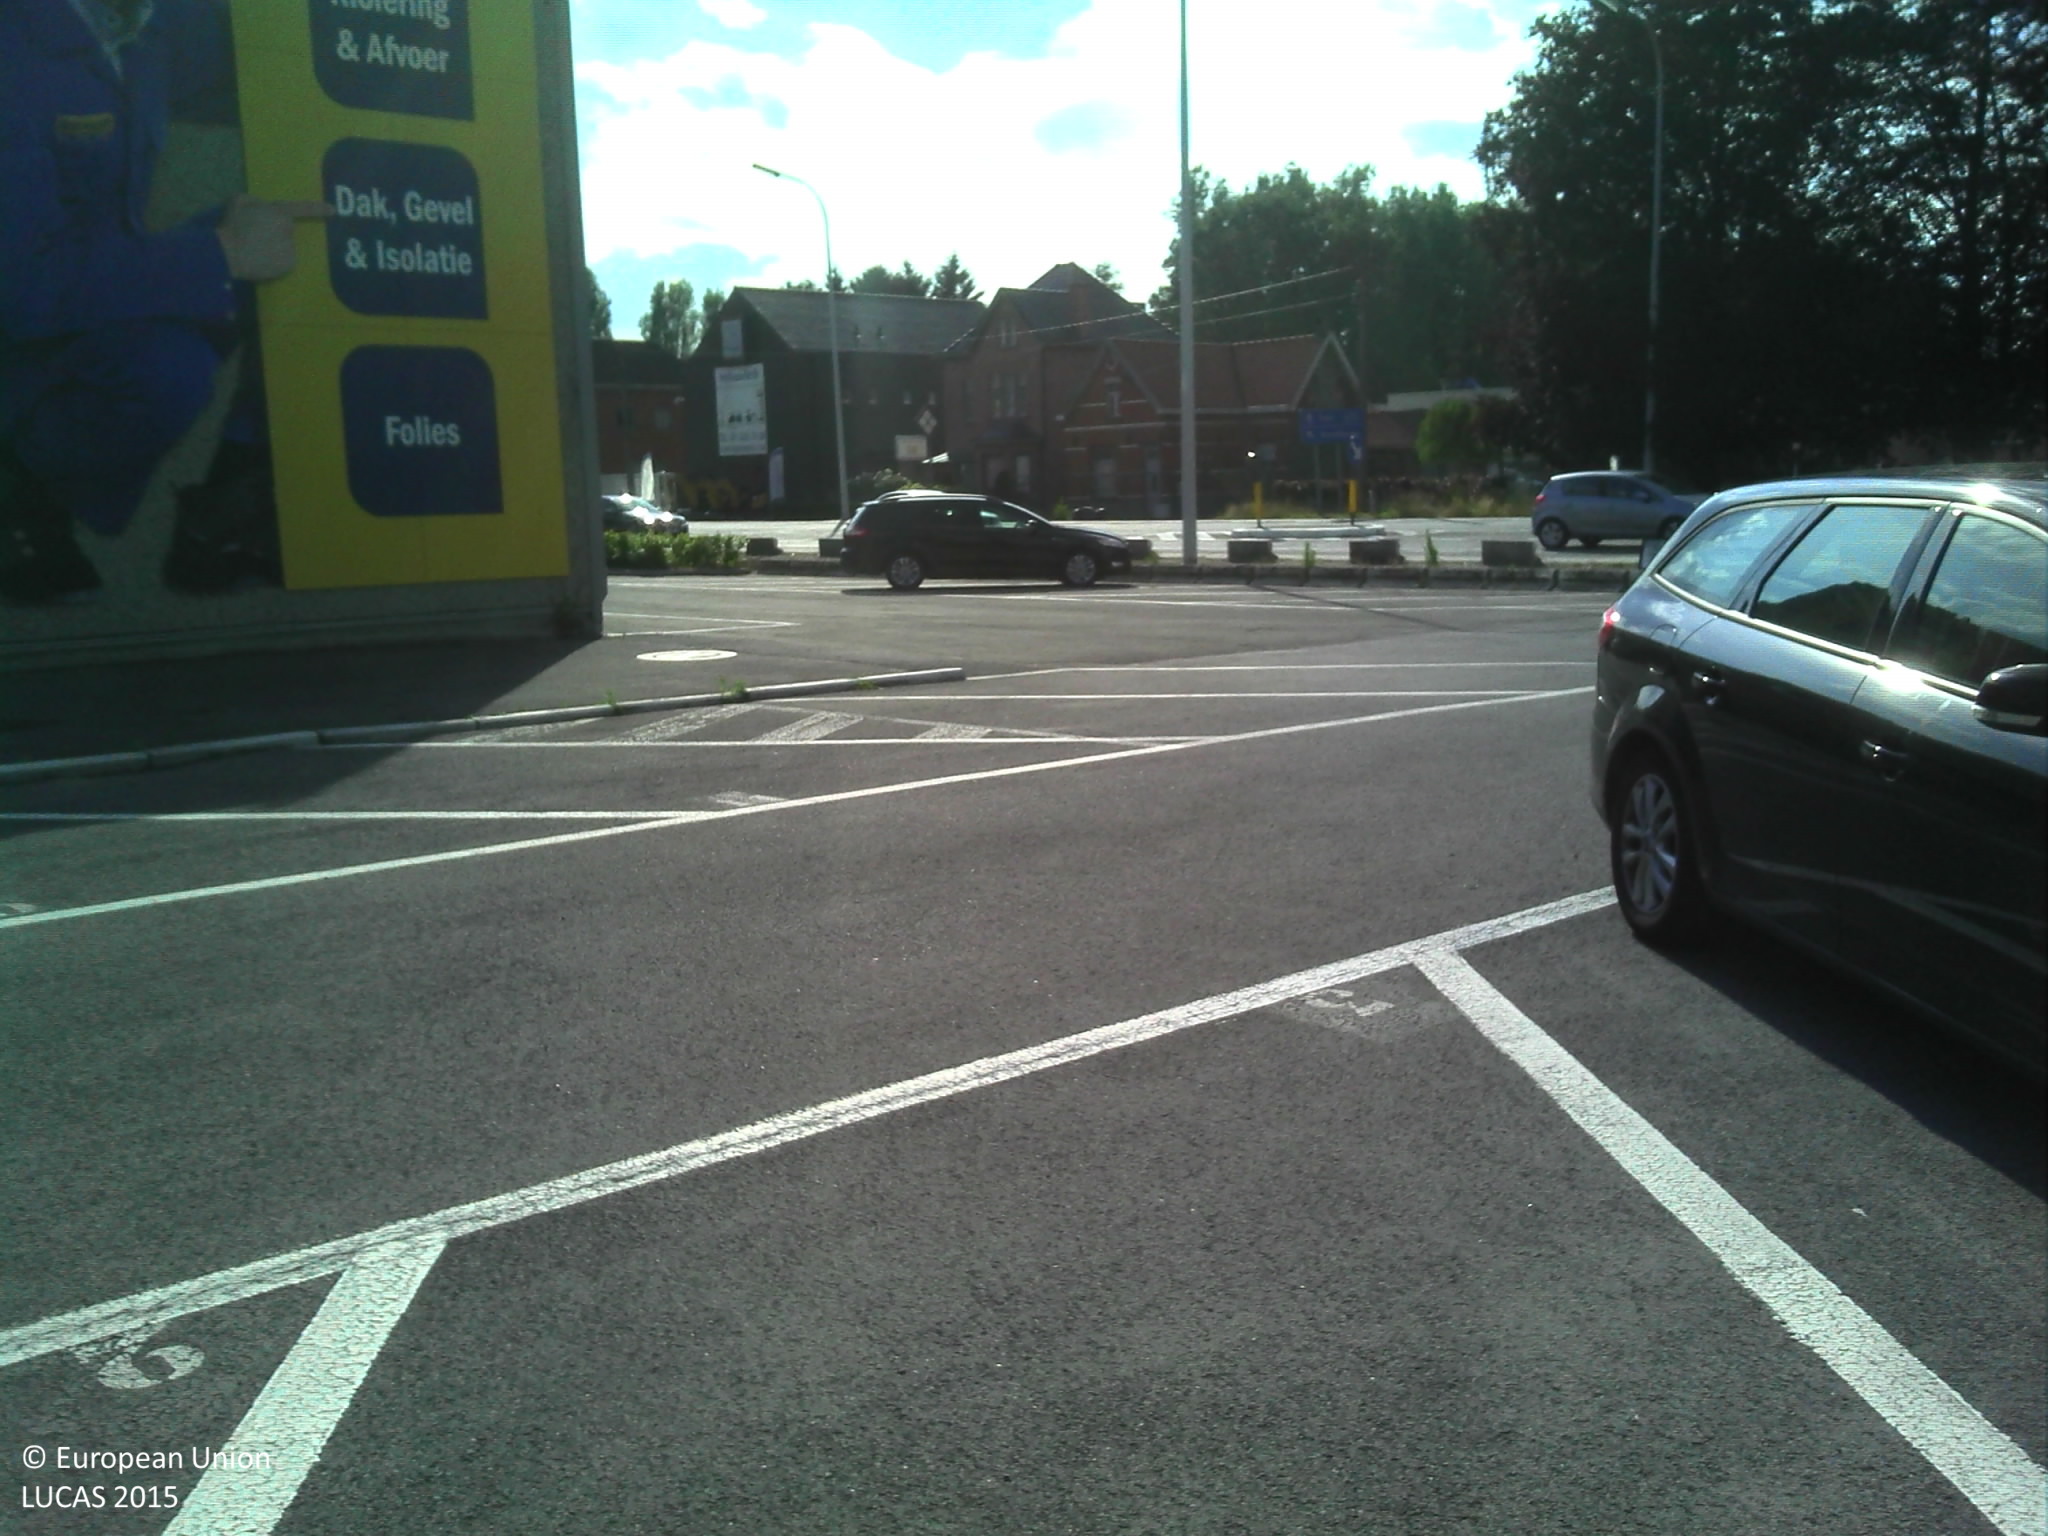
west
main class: Cropland
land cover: Floriculture and ornamental plants
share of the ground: > 75 %
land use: Community services
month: June
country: BE
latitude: 51.0787
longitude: 3.7842
